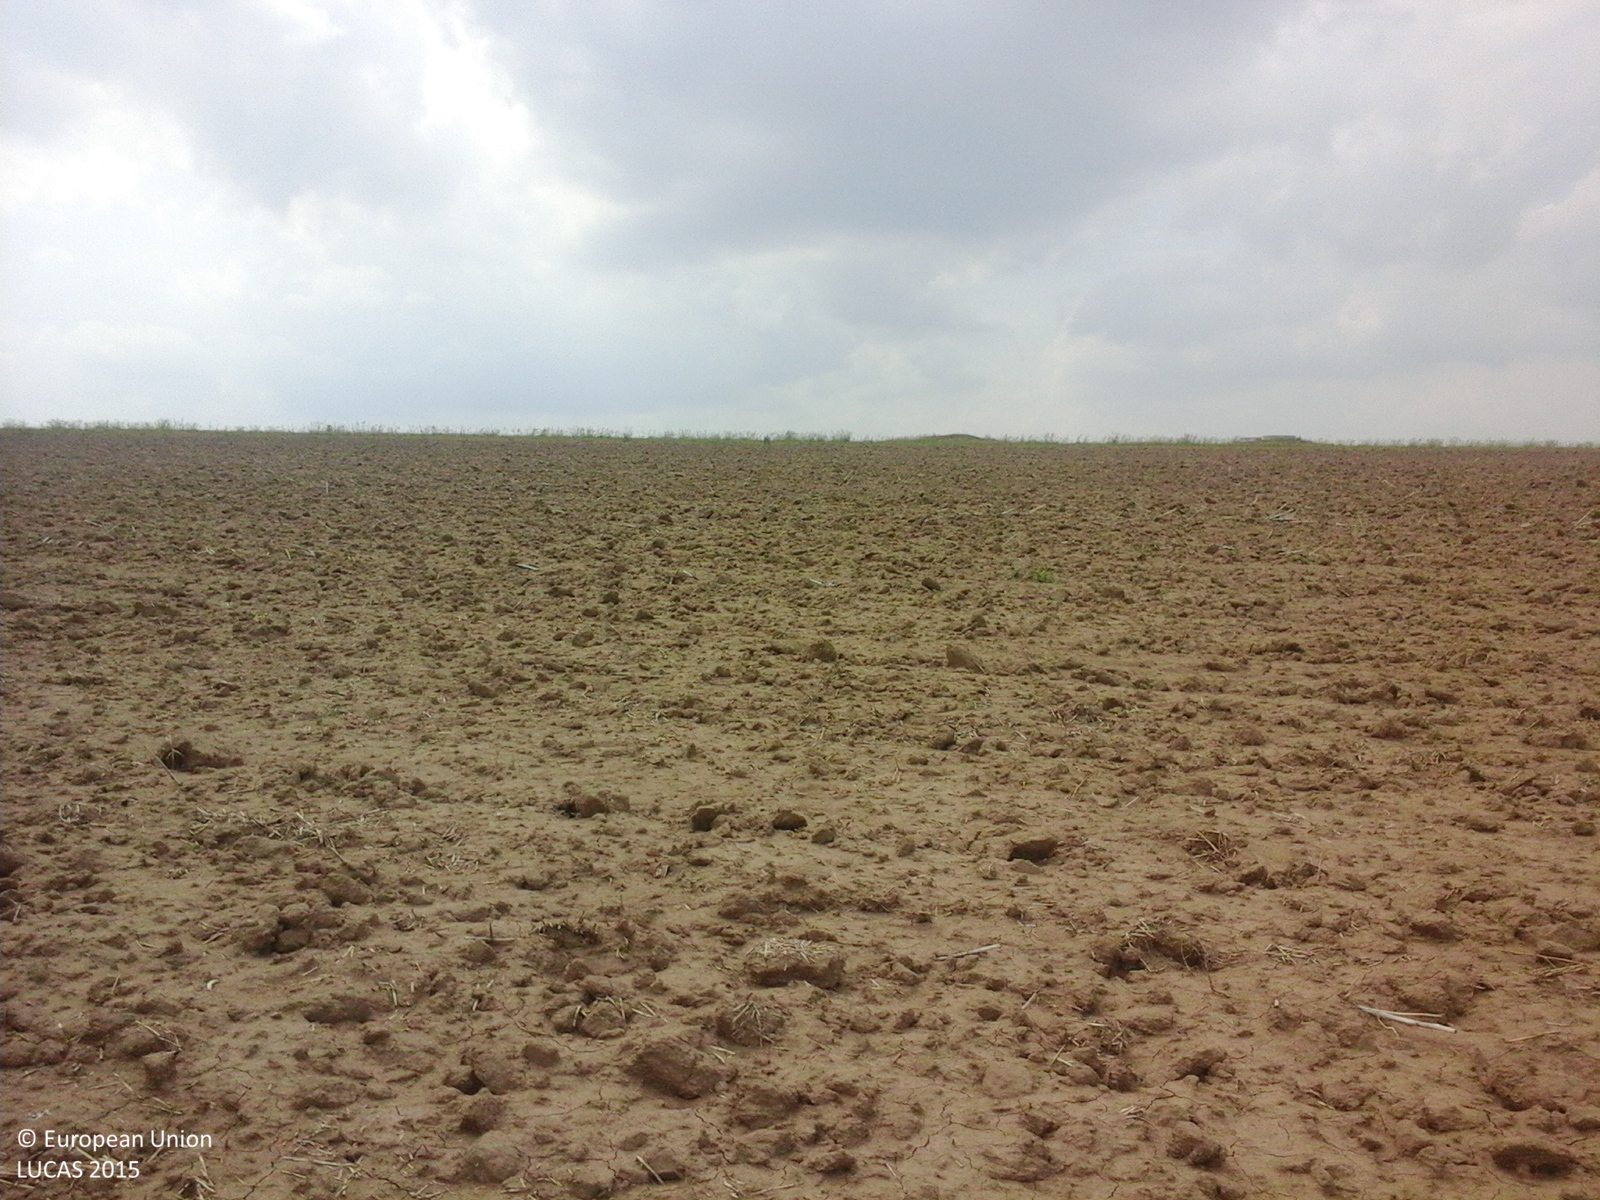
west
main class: Cropland
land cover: Dry pulses
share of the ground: 10 - 25 %
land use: Agriculture (excluding fallow land and kitchen gardens)
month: July
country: RO
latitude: 44.9708
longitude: 28.8423
